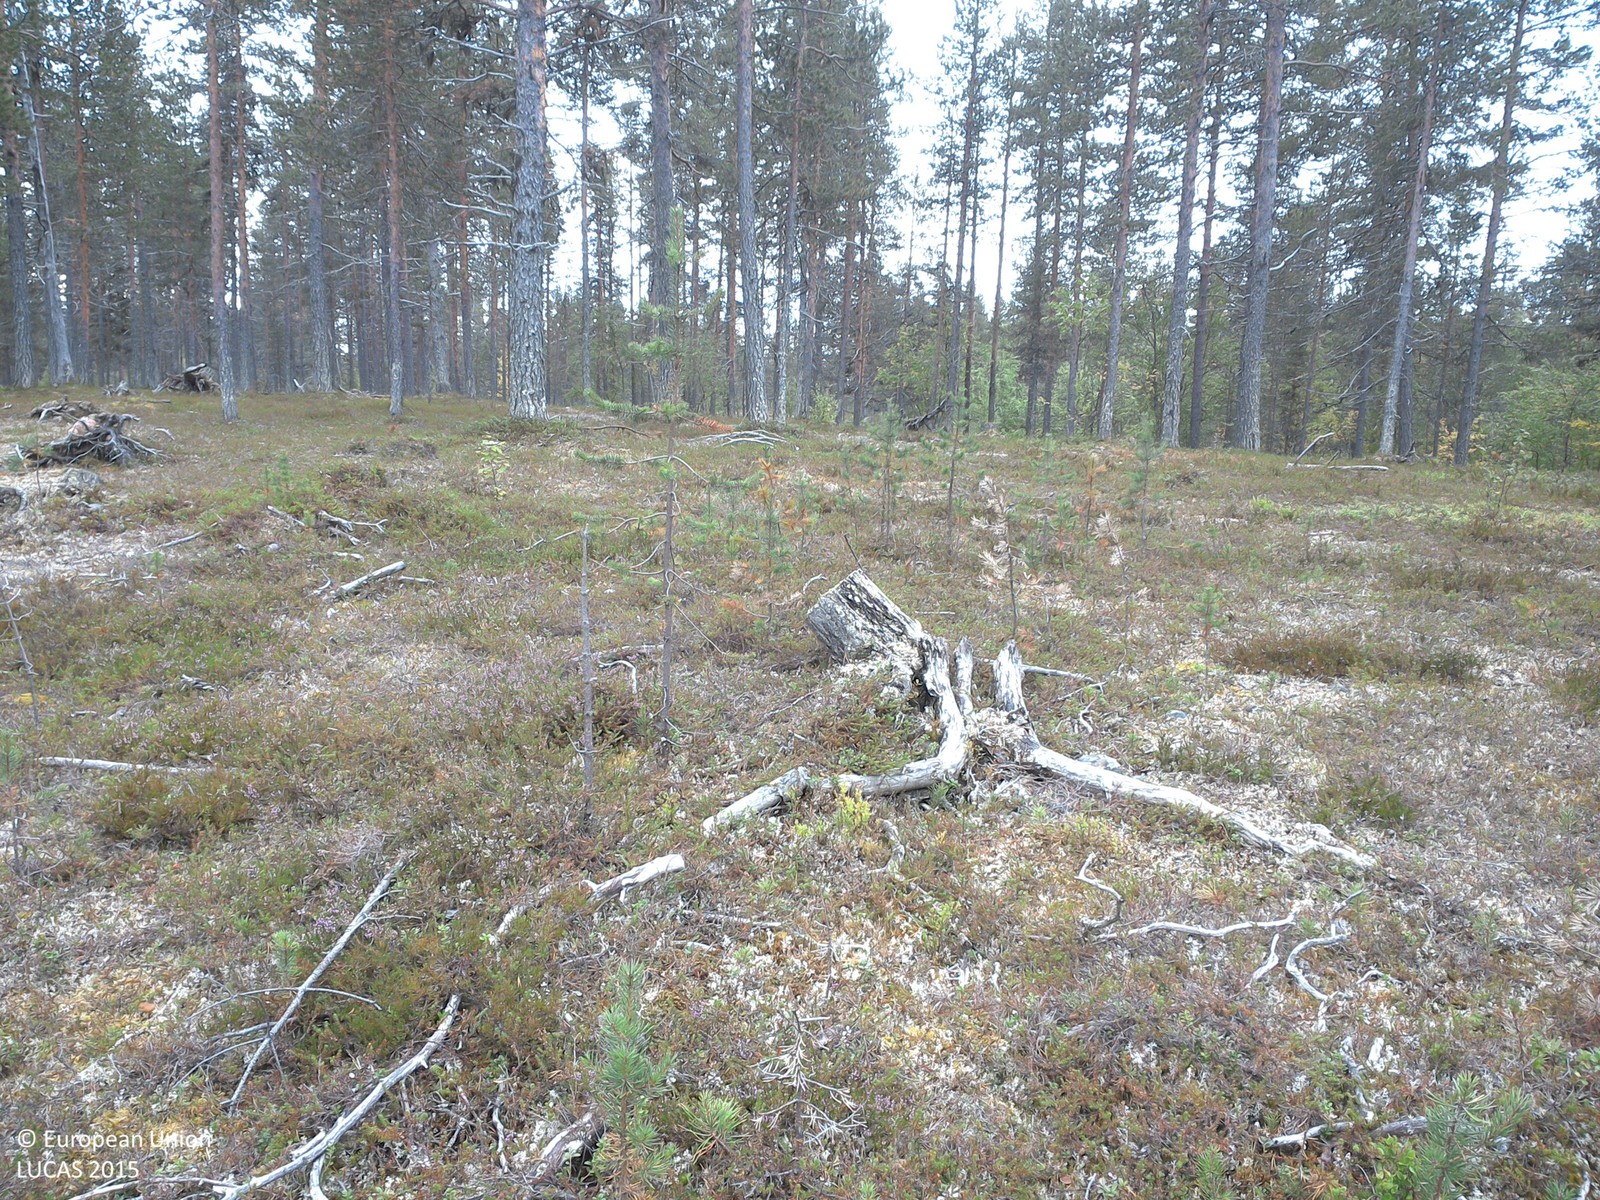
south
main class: Woodland
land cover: Pine dominated coniferous woodland
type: boreal forest
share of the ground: 10 - 25 %
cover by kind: shrubs 50 %, lichens and mosses 35 %, coniferous forest trees 15 %
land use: Forestry
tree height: > 5 m
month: August
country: SE
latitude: 67.9479
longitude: 23.2048
